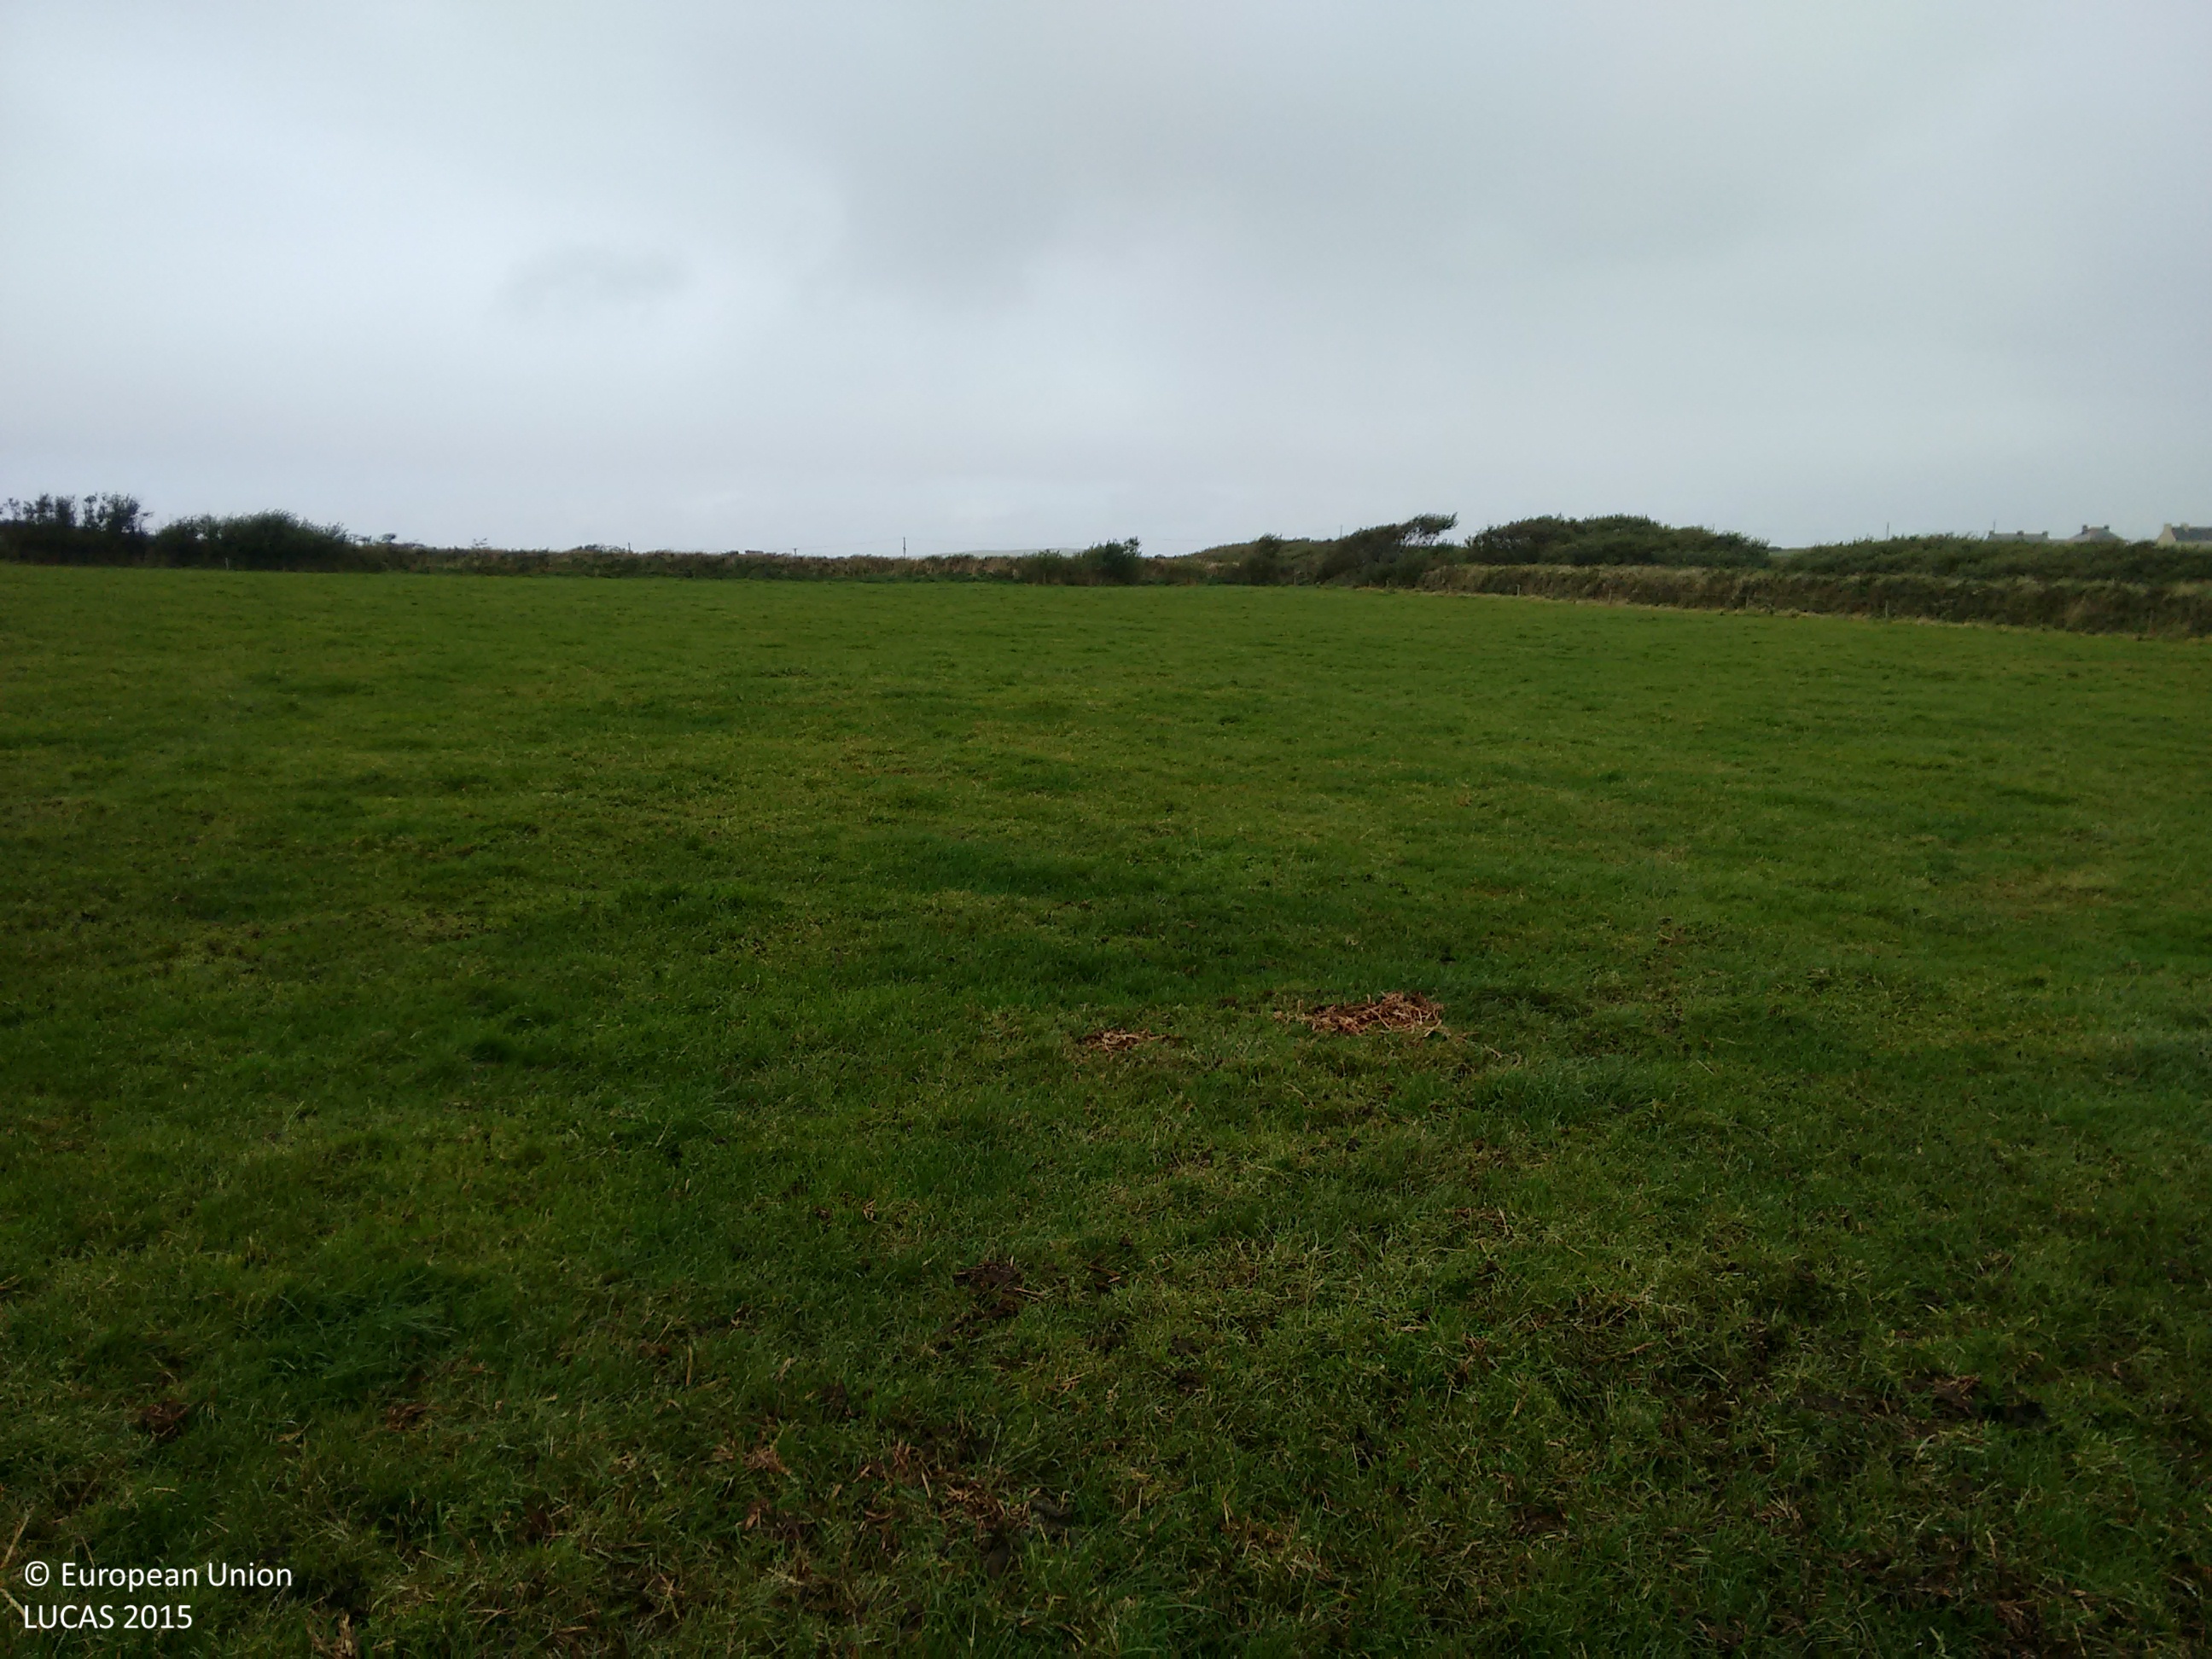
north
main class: Grassland
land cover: Grassland without tree/shrub cover
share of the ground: > 75 %
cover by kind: herbaceous plants 95 %, unconsolidated bare surface 5 %
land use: Agriculture (excluding fallow land and kitchen gardens)
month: September
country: IE
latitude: 52.7014
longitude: -9.6089
